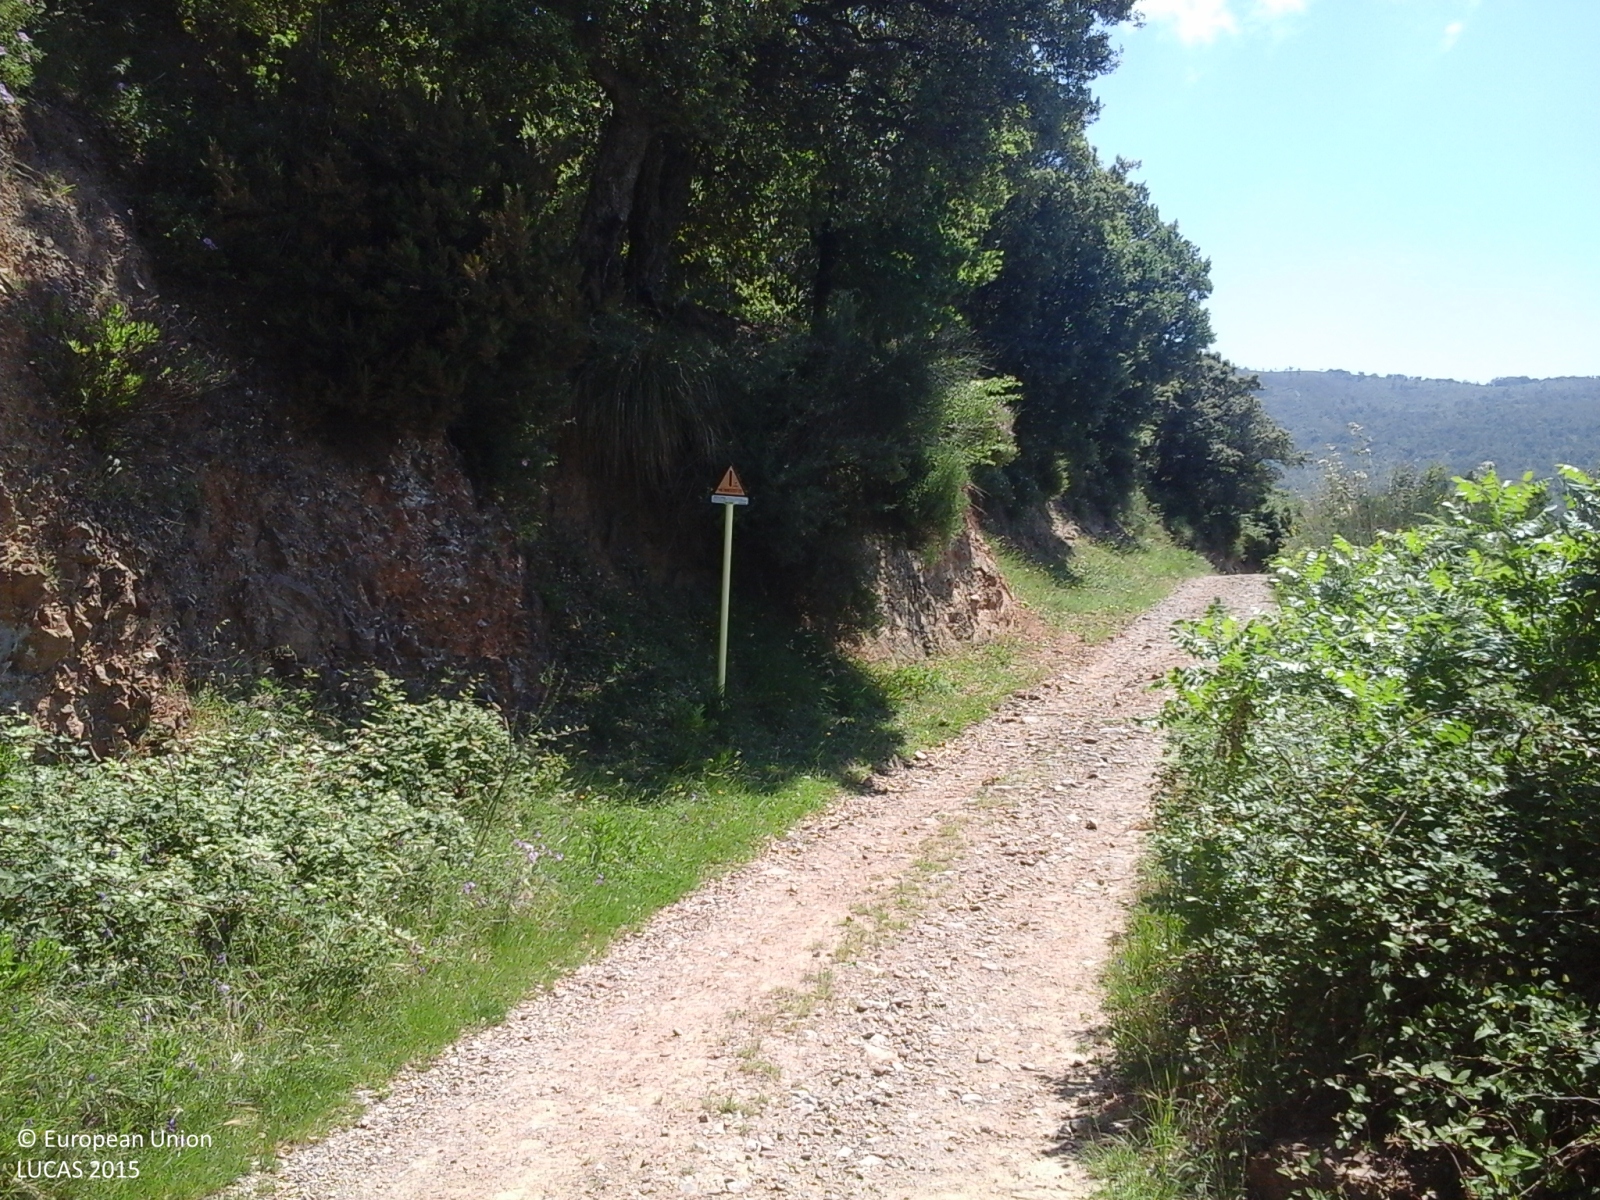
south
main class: Shrubland
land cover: Shrubland with sparse tree cover
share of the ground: > 75 %
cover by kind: shrubs 55 %, herbaceous plants 40 %, broadleaved forest trees 5 %
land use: Agriculture (excluding fallow land and kitchen gardens)
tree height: < 5 m
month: June
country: IT
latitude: 37.9555
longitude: 13.9669
